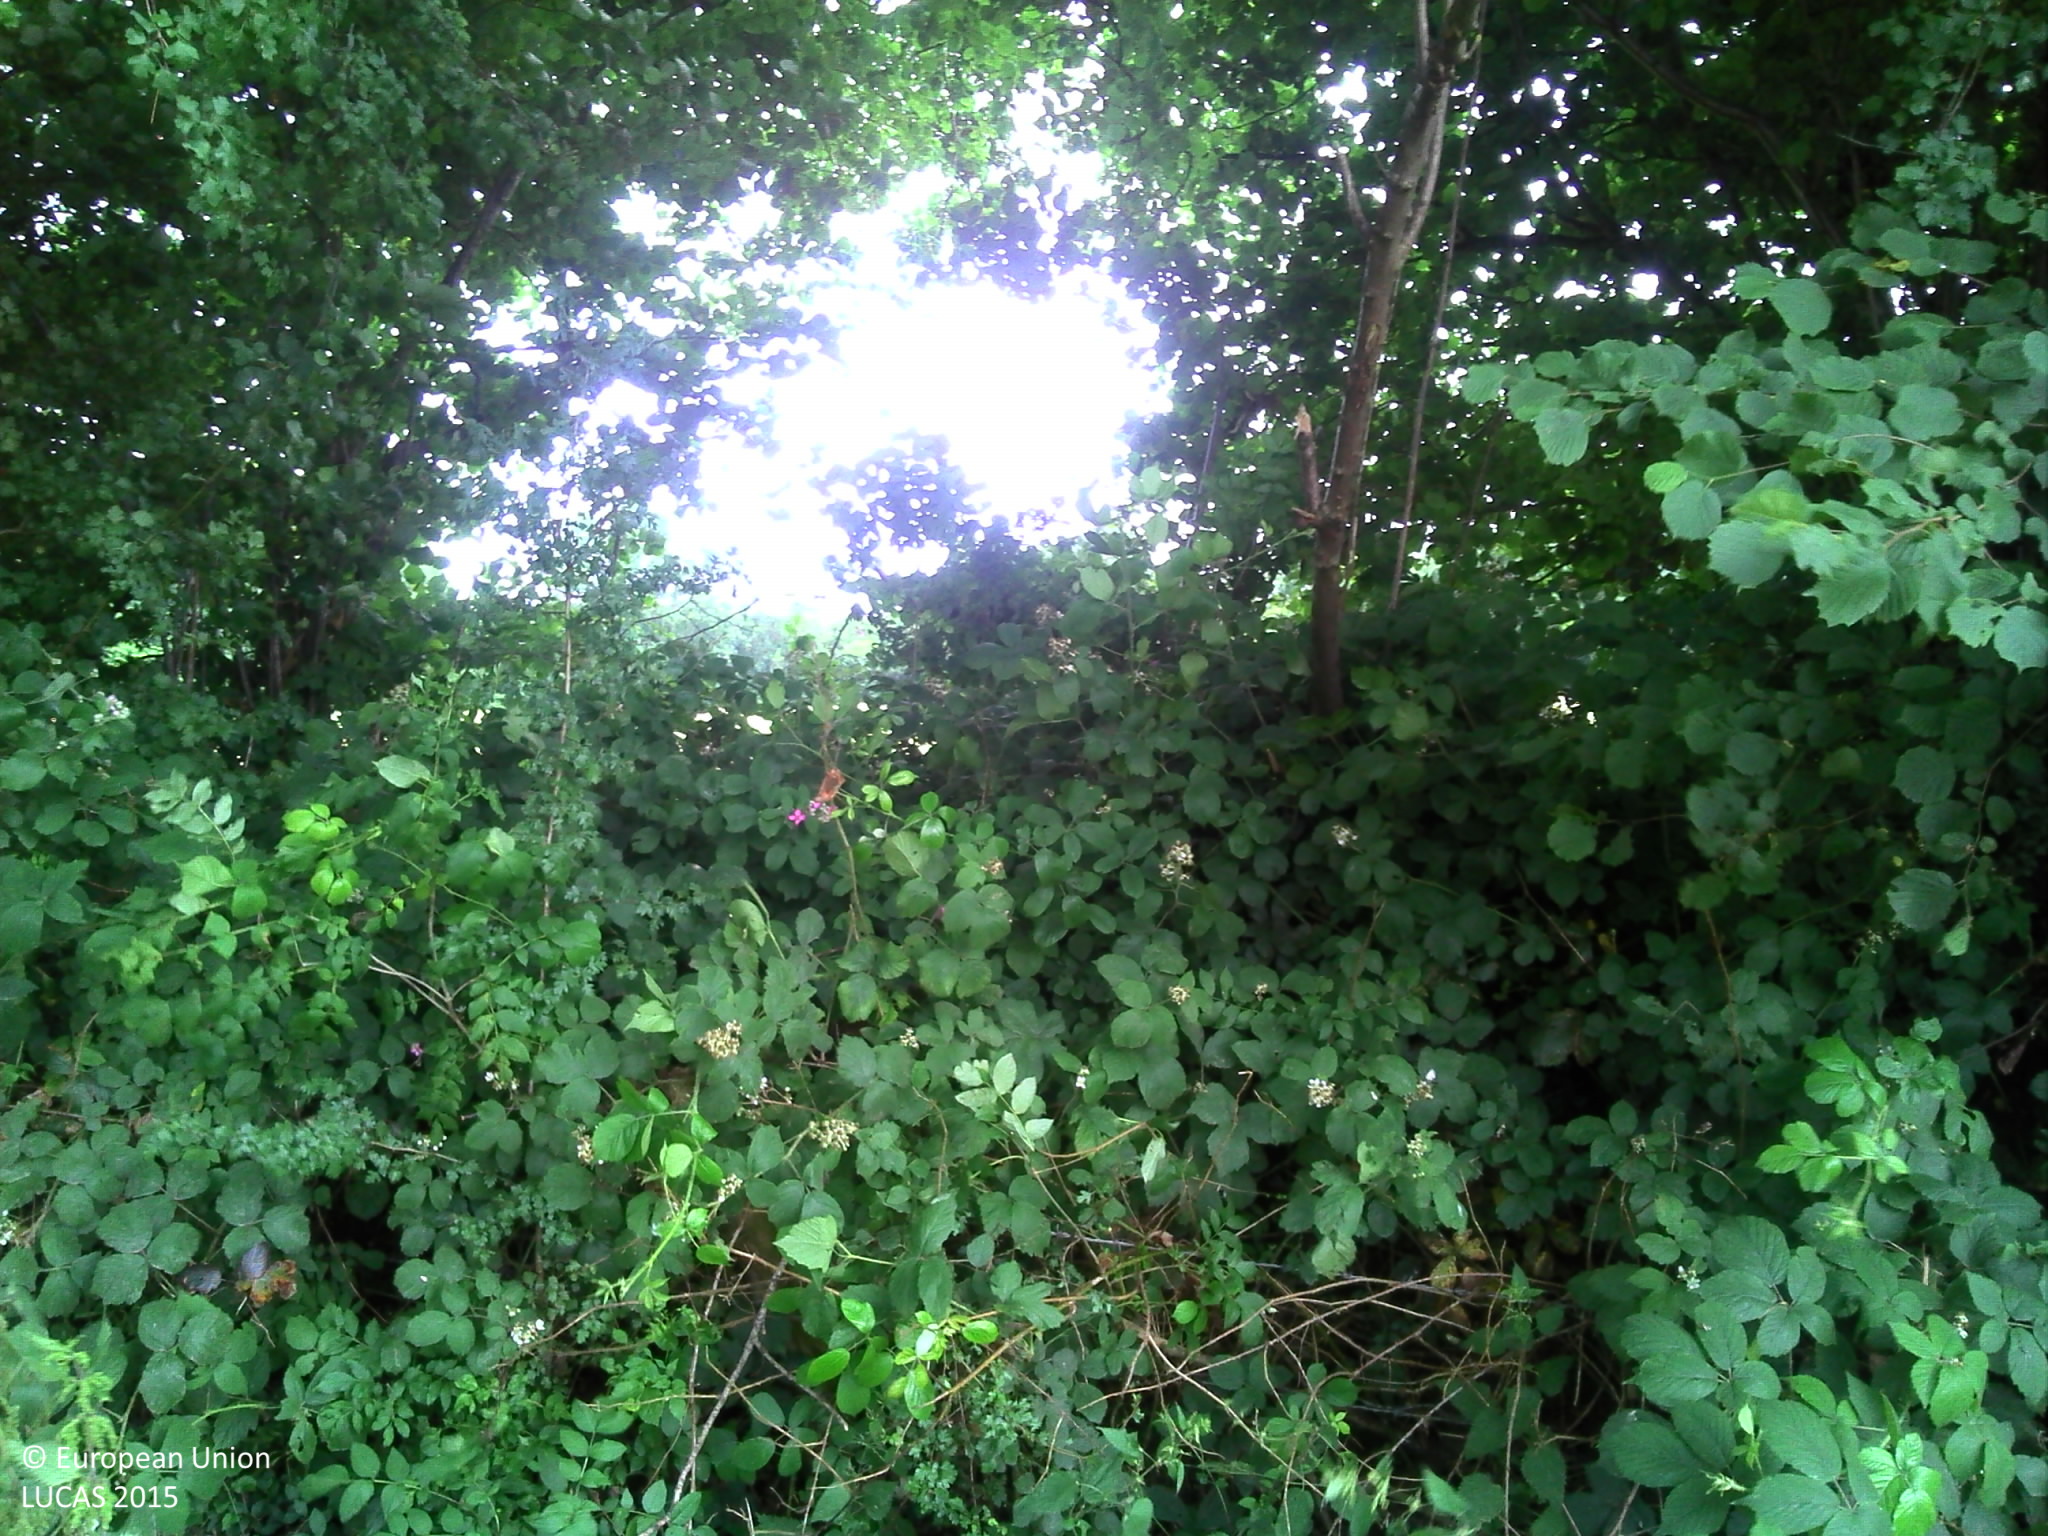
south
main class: Grassland
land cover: Grassland without tree/shrub cover
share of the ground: > 75 %
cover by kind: herbaceous plants 100 %
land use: Agriculture (excluding fallow land and kitchen gardens)
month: July
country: FR
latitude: 49.2396
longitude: 0.4549
